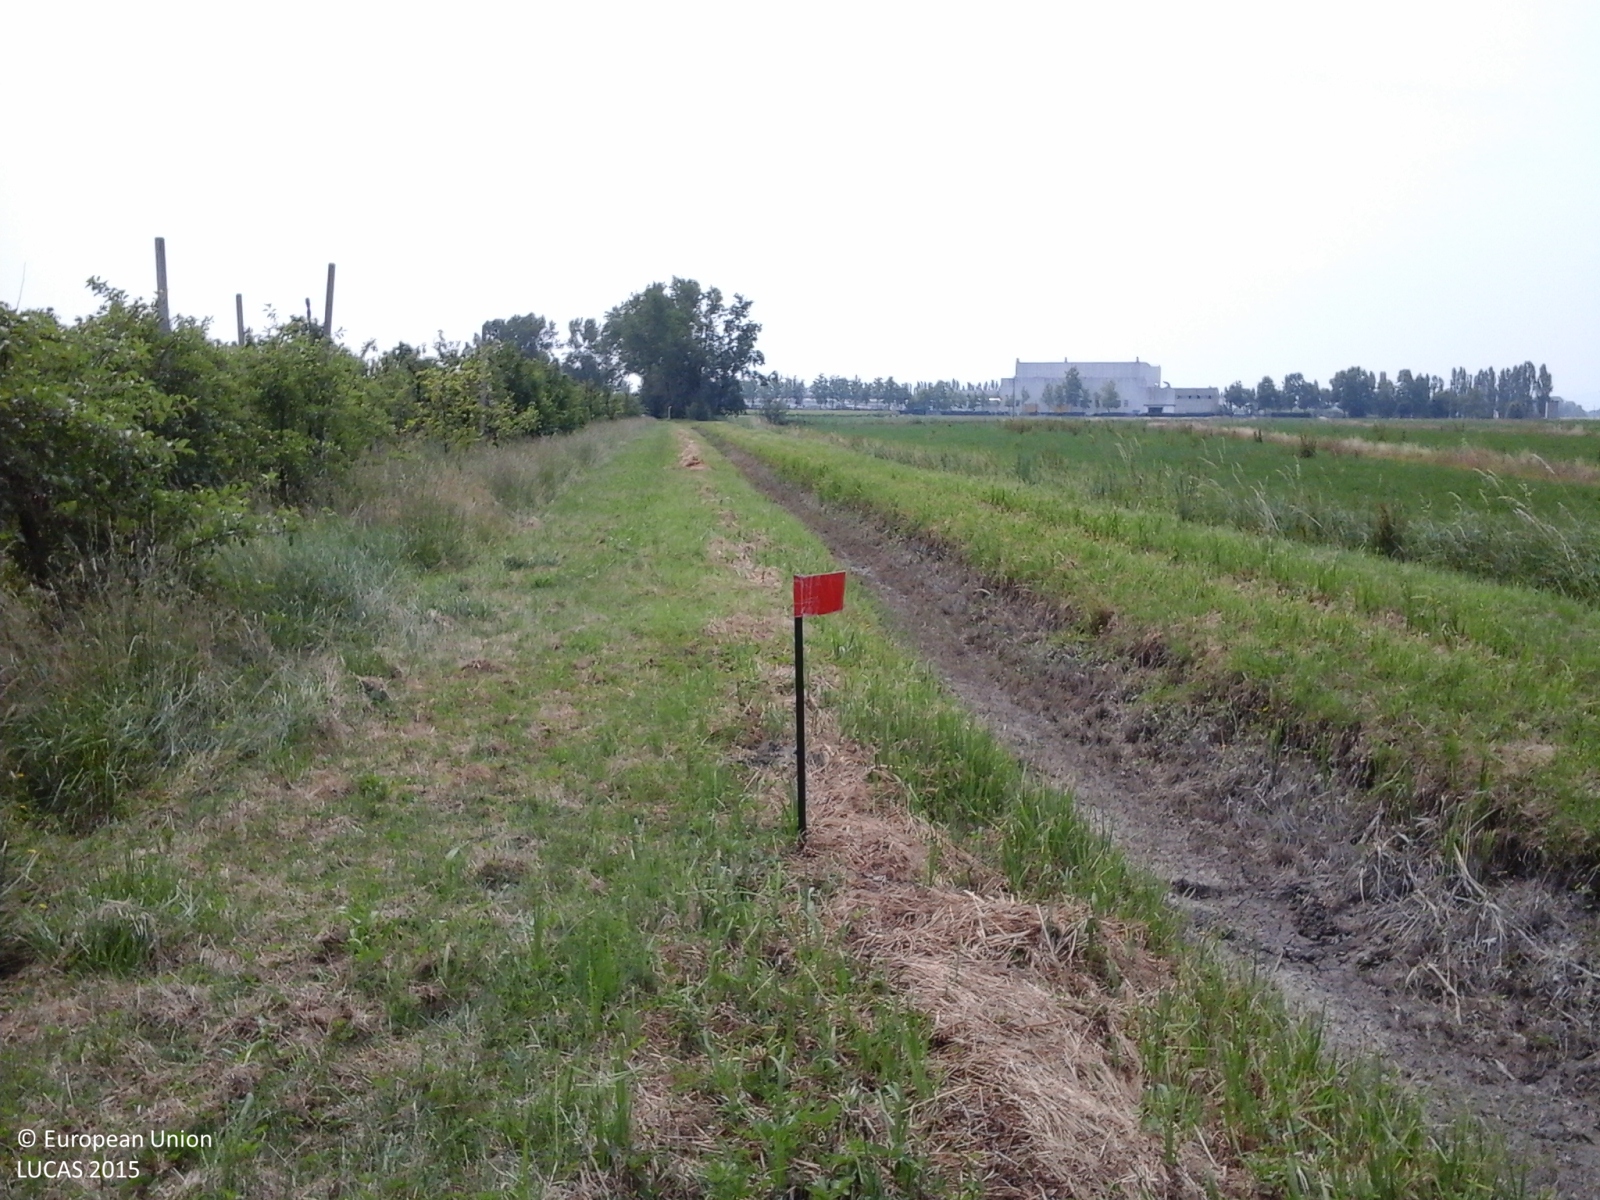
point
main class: Grassland
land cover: Grassland without tree/shrub cover
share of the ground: > 75 %
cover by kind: herbaceous plants 100 %
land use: Agriculture (excluding fallow land and kitchen gardens)
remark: Clear cut
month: May
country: IT
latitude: 44.7441
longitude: 10.8192
